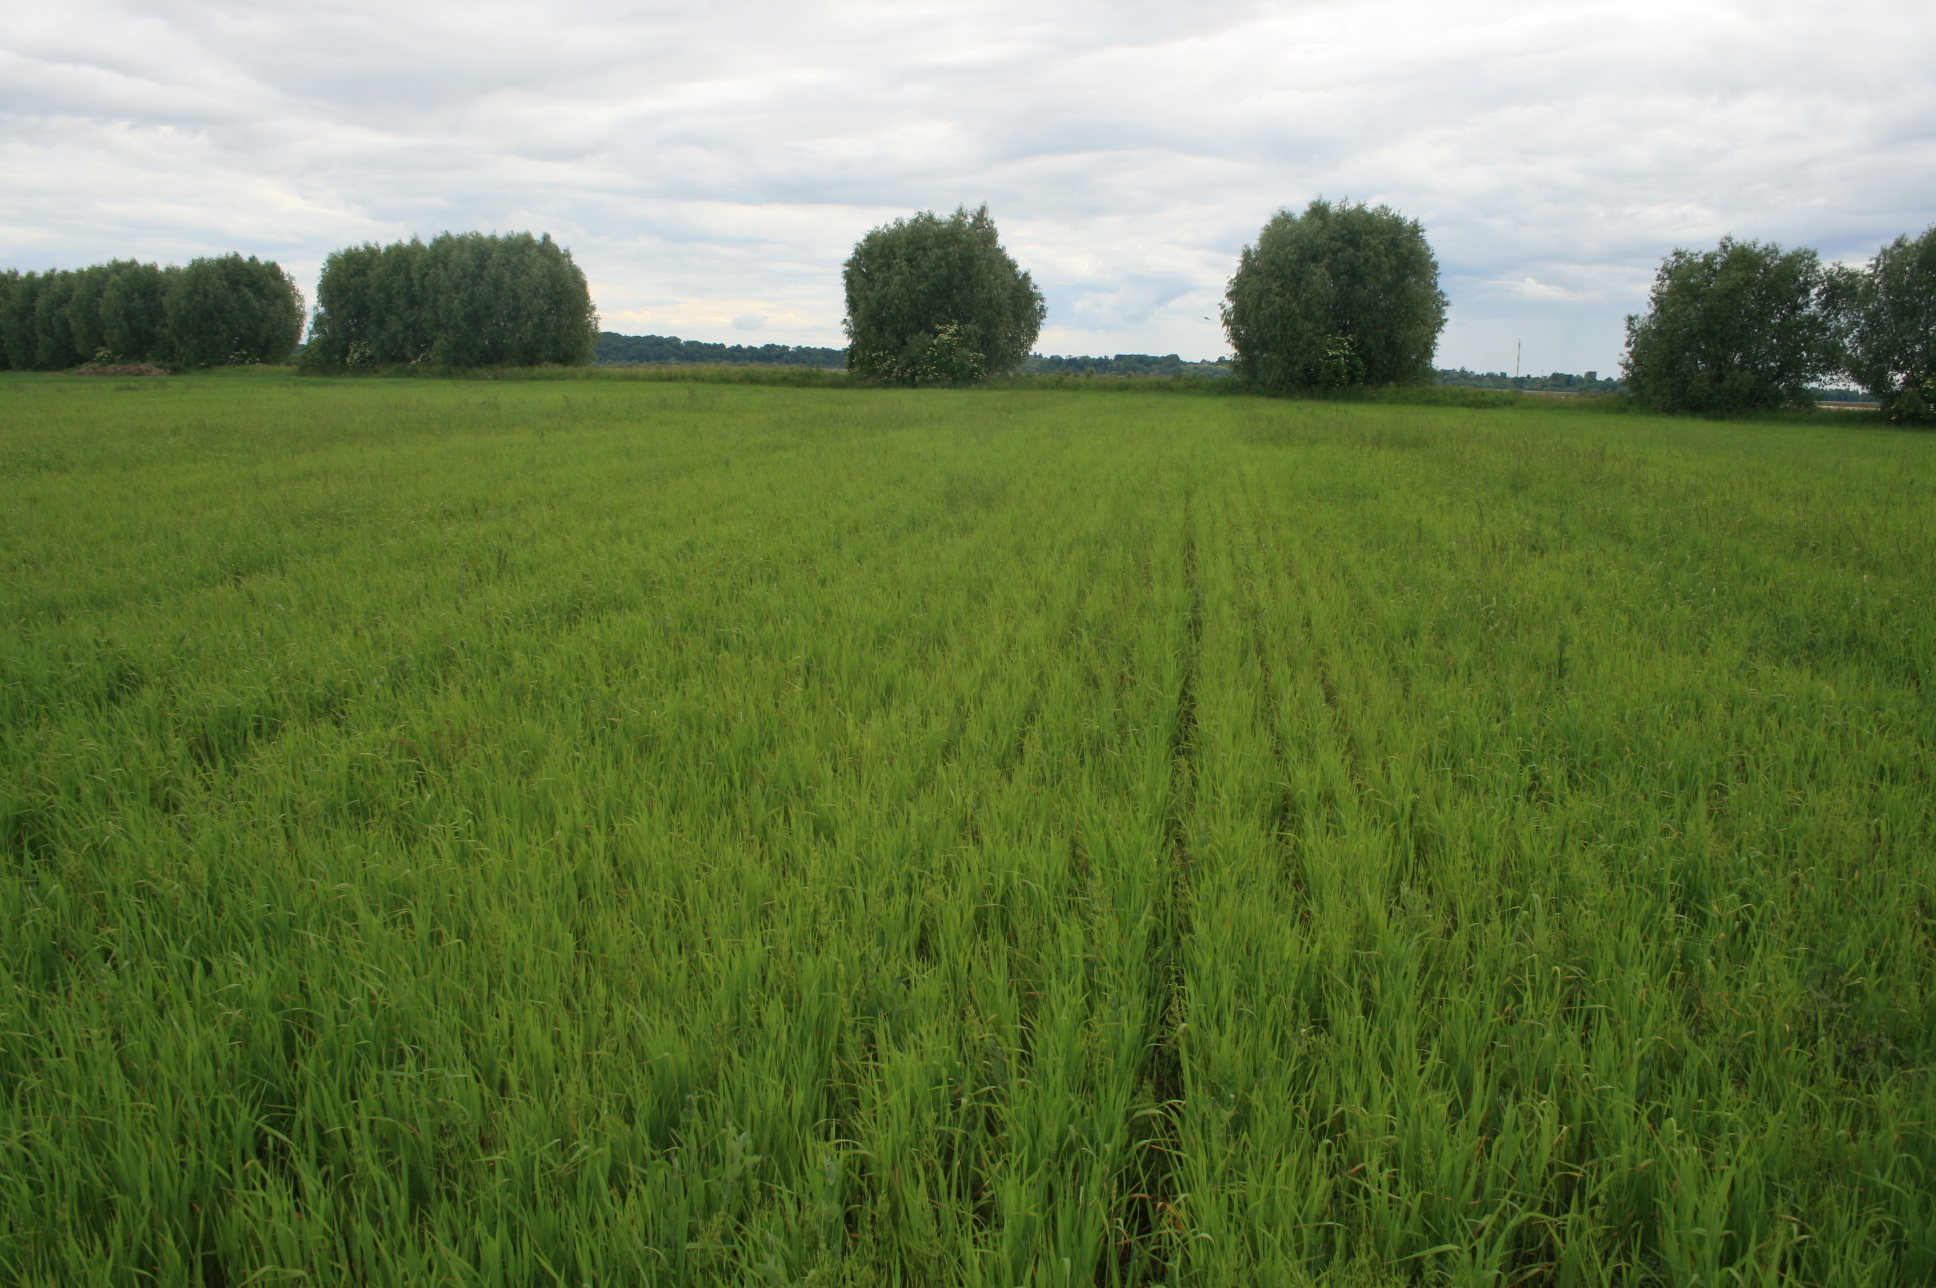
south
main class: Cropland
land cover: Mixed cereals for fodder
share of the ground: > 75 %
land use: Agriculture (excluding fallow land and kitchen gardens)
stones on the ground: < 10 %
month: June
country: LT
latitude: 55.0994
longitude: 21.9484
